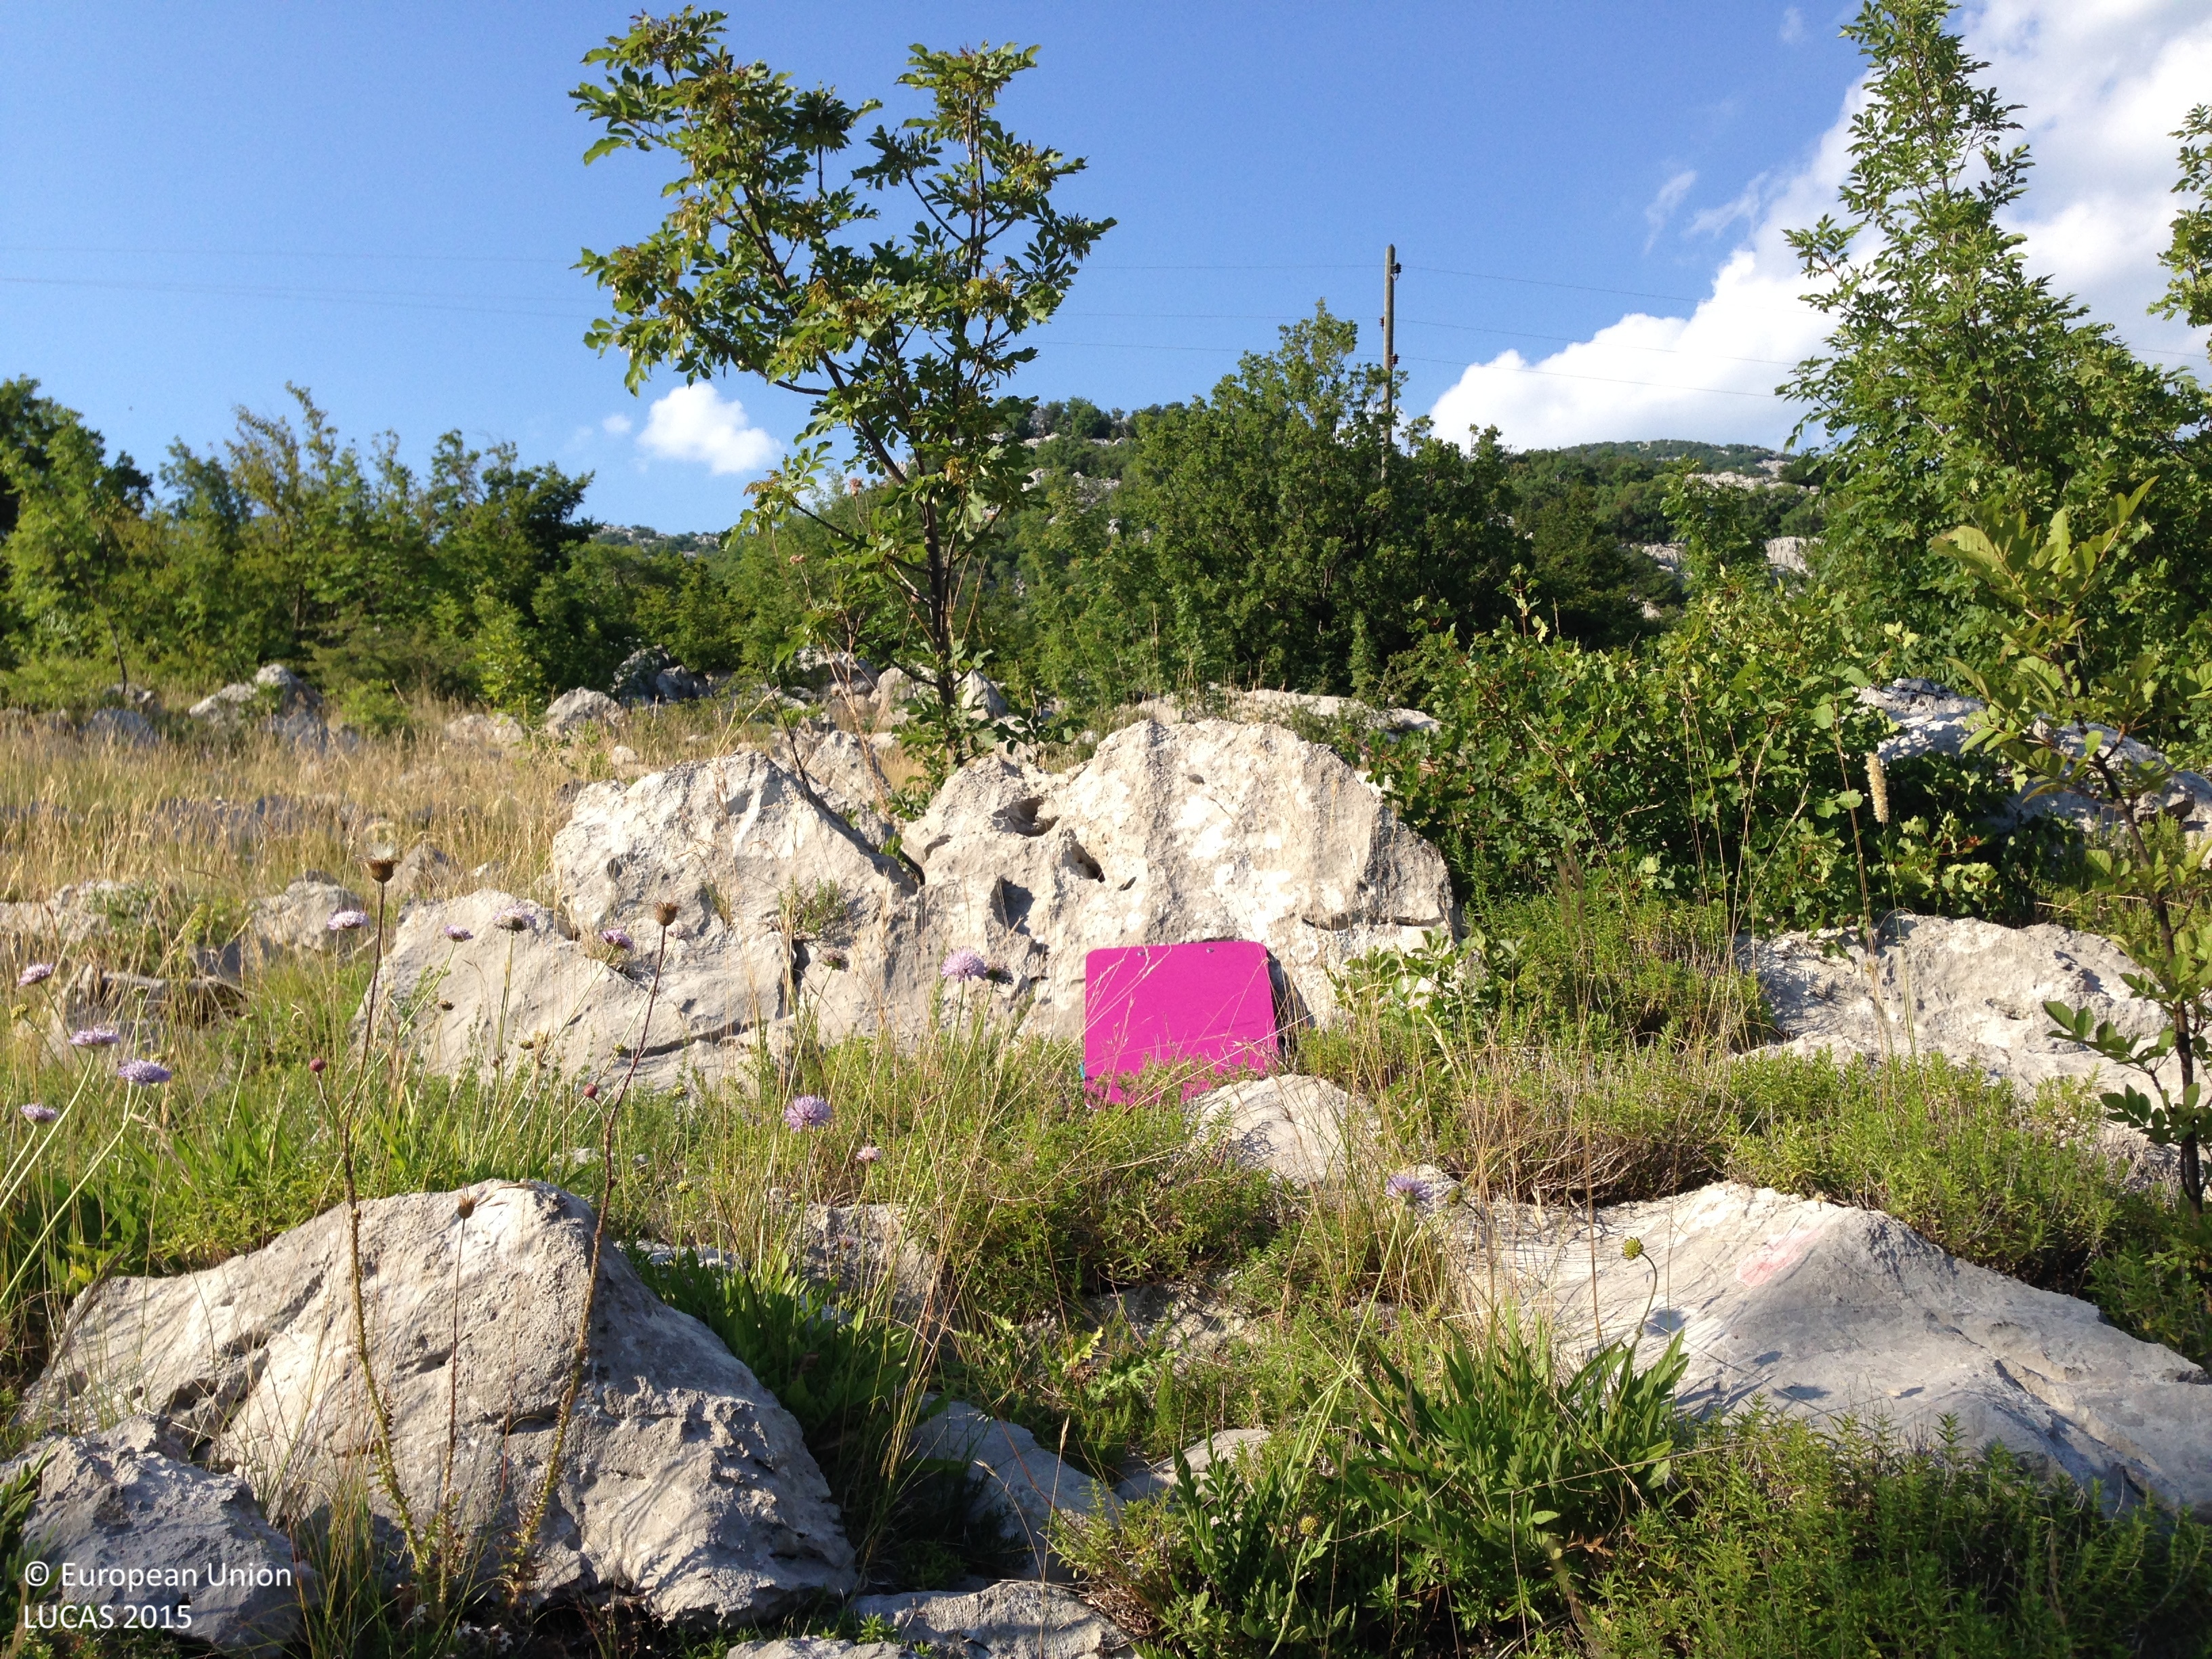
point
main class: Shrubland
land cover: Shrubland with sparse tree cover
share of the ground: 10 - 25 %
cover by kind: herbaceous plants 40 %, shrubs 25 %, consolidated bare surface 15 %, unconsolidated bare surface 15 %, broadleaved forest trees 5 %
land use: Semi-natural and natural areas not in use
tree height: < 5 m
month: July
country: HR
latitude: 44.5124
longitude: 15.1382
